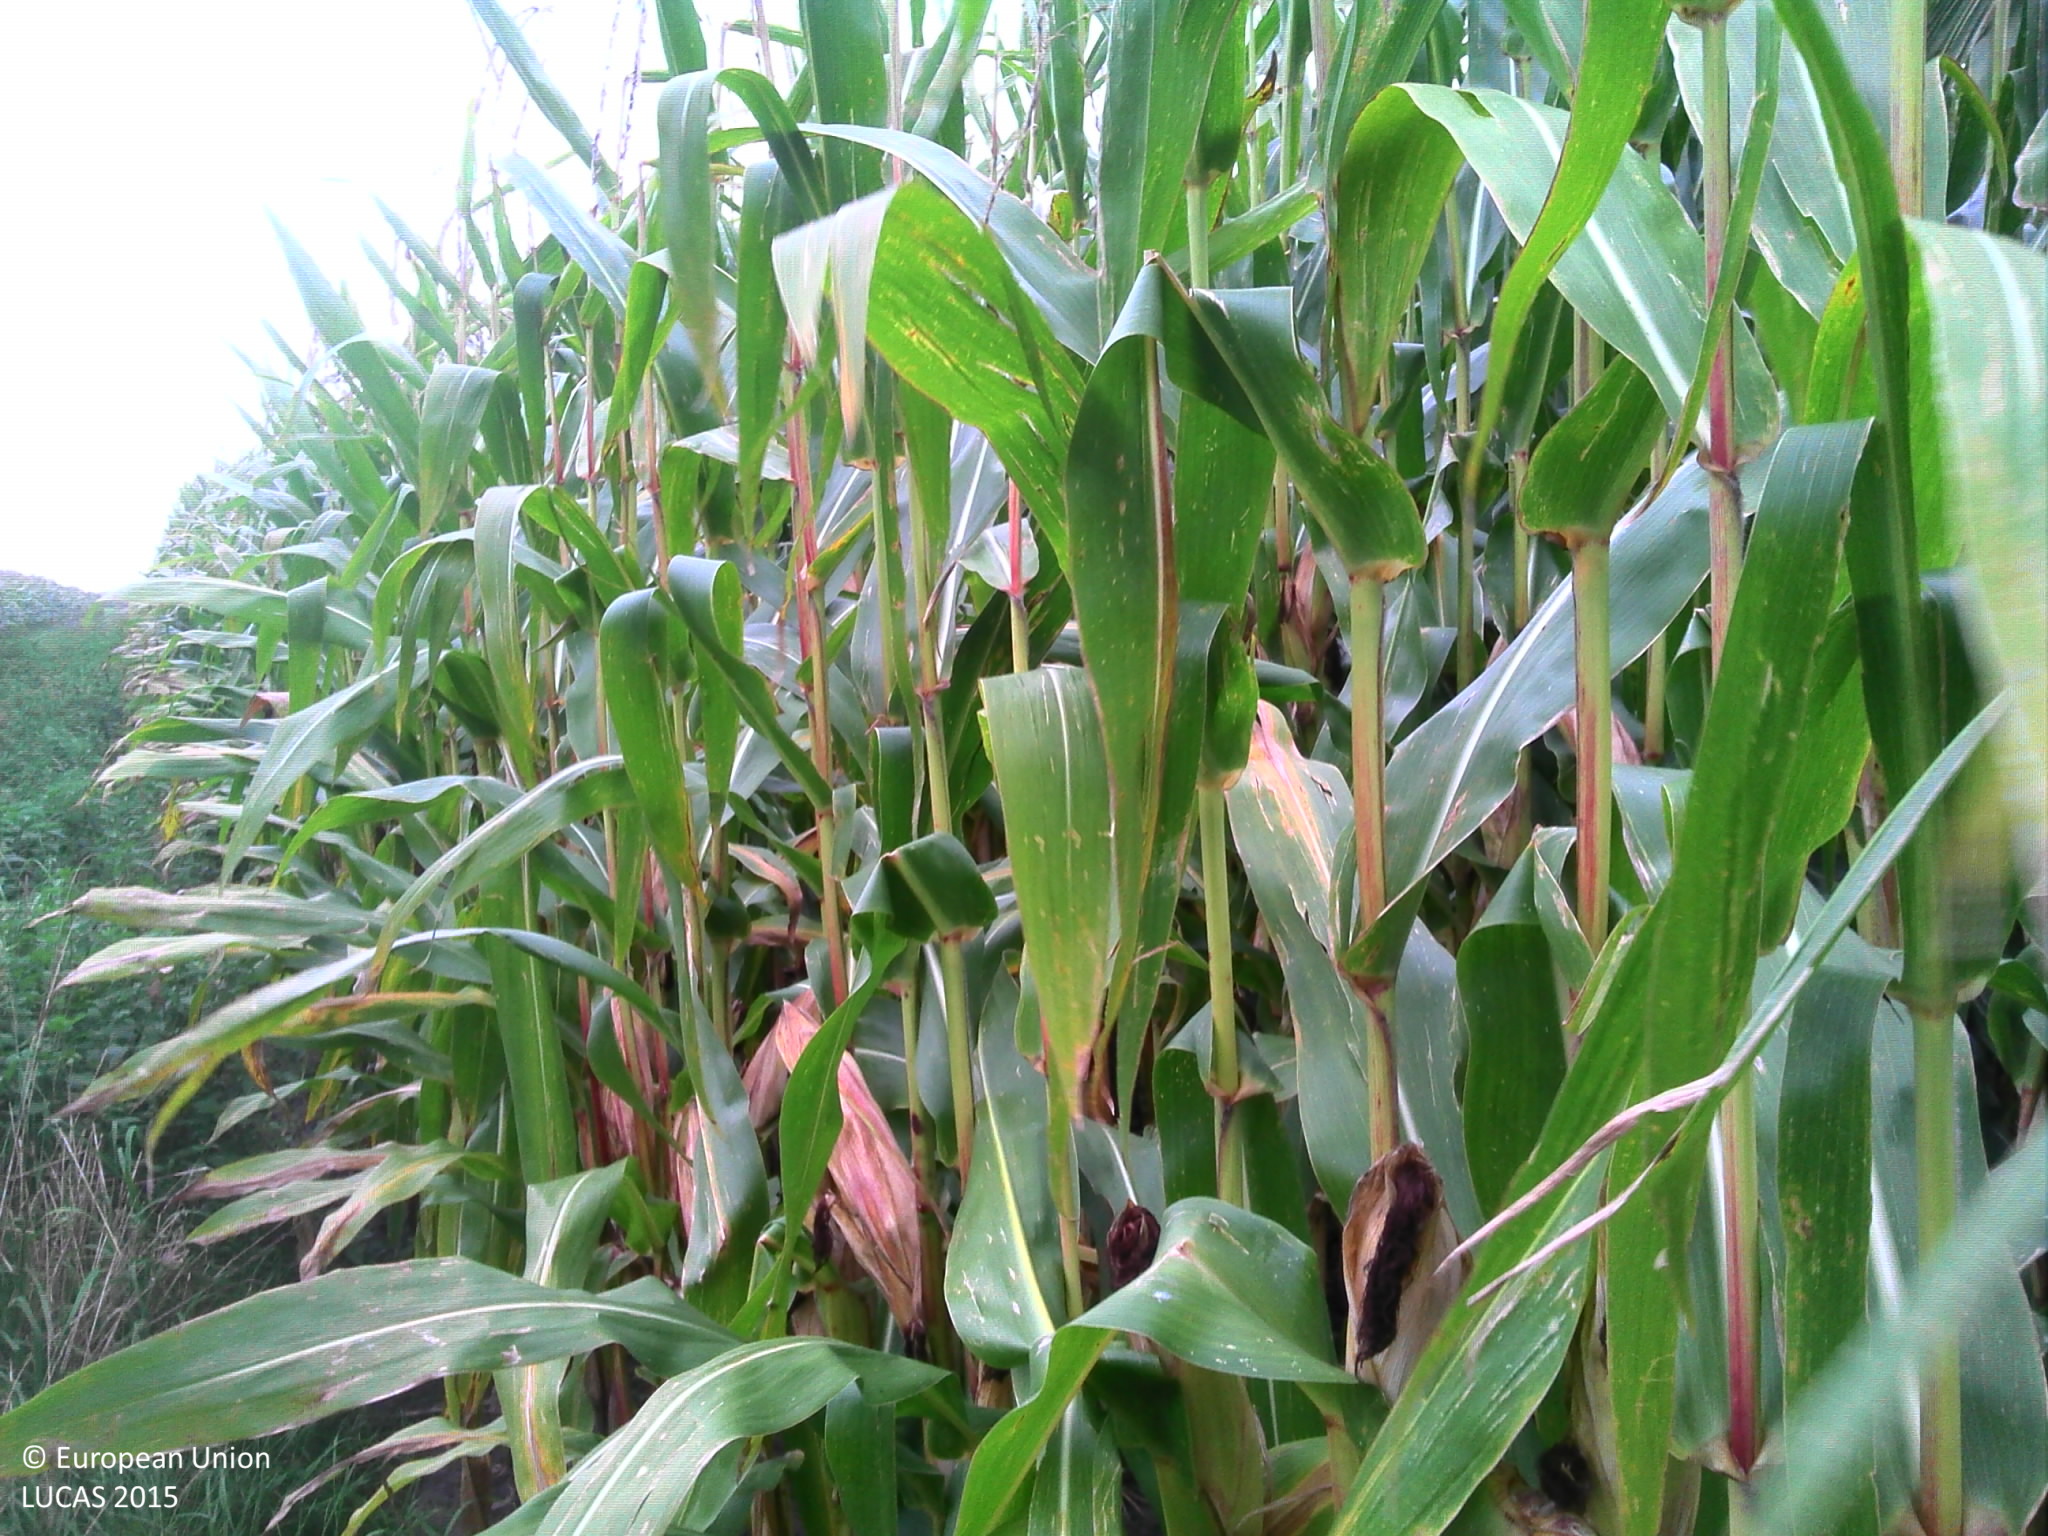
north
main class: Cropland
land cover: Maize
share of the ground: > 75 %
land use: Agriculture (excluding fallow land and kitchen gardens)
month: September
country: BE
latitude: 51.1209
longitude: 2.9461
